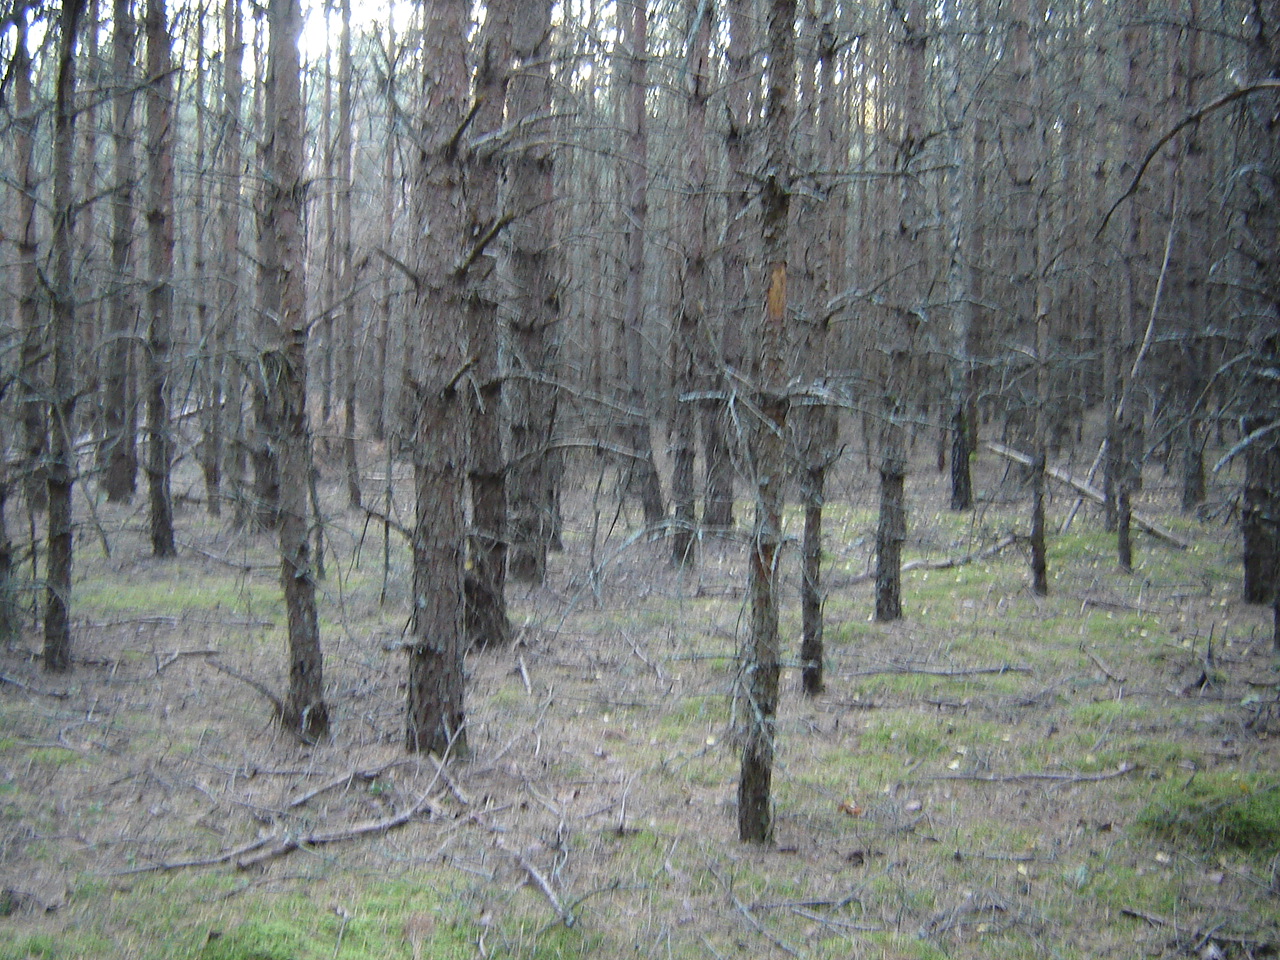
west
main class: Woodland
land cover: Pine dominated coniferous woodland
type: hemiboreal forest and nemoral coniferous forest and mixed broadleaved-coniferous forest
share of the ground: > 75 %
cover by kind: coniferous forest trees 90 %, lichens and mosses 10 %
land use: Forestry
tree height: > 5 m
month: August
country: LT
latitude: 54.5658
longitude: 24.8504
